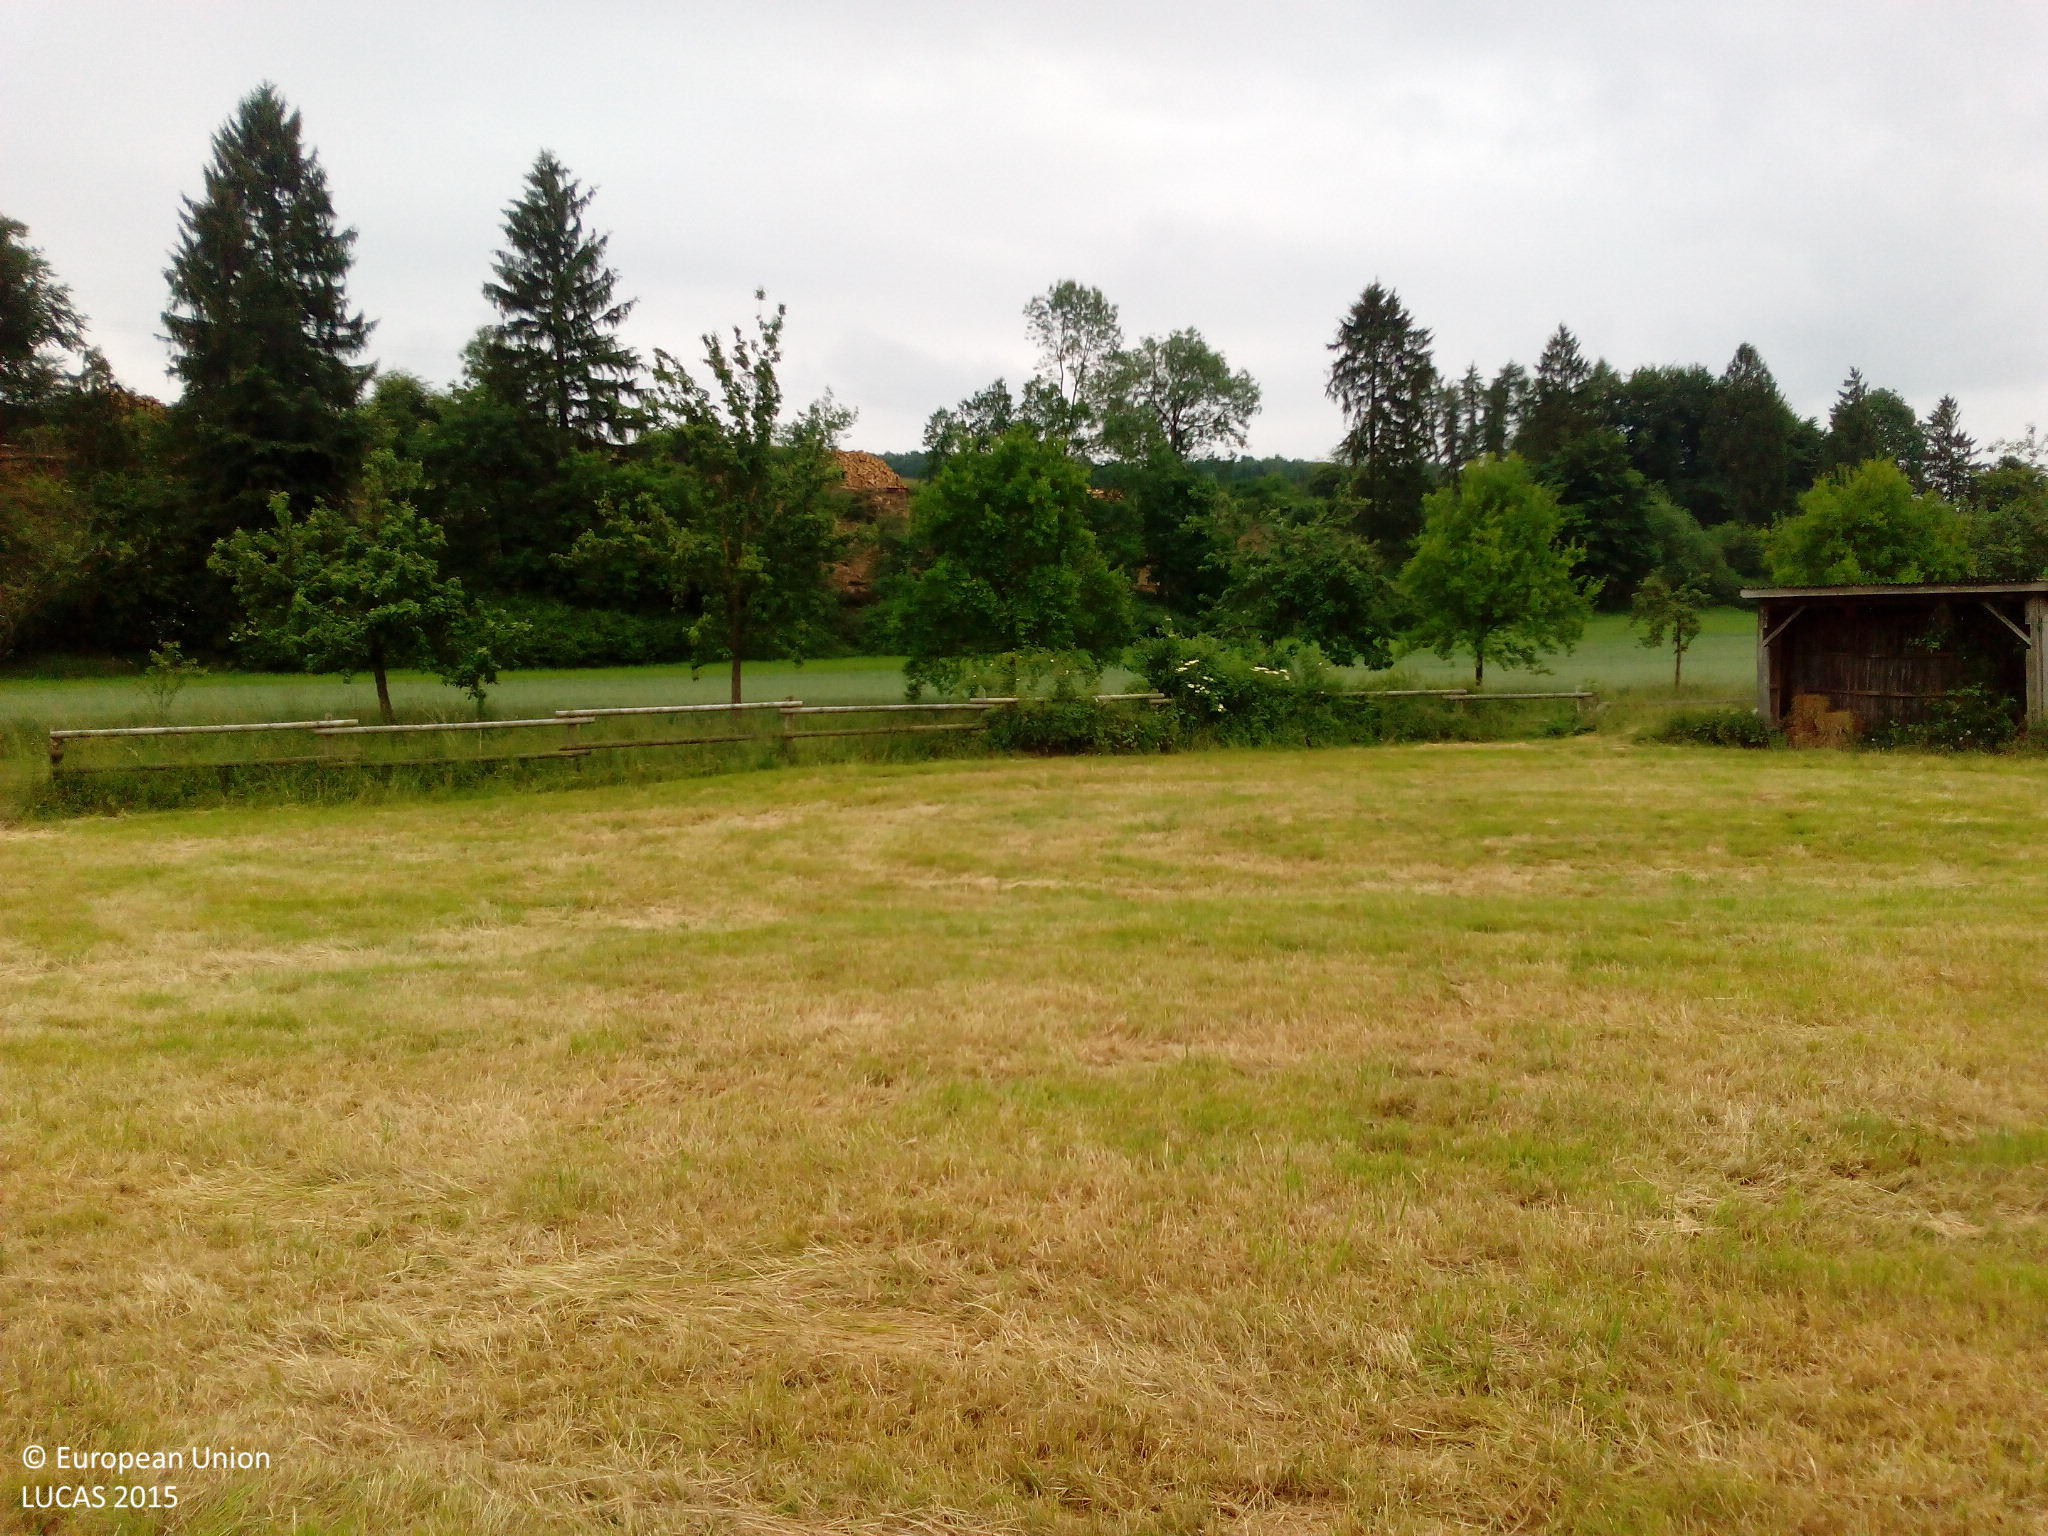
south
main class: Grassland
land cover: Grassland without tree/shrub cover
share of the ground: > 75 %
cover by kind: herbaceous plants 100 %
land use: Agriculture (excluding fallow land and kitchen gardens)
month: June
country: DE
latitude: 51.5779
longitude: 8.5718
